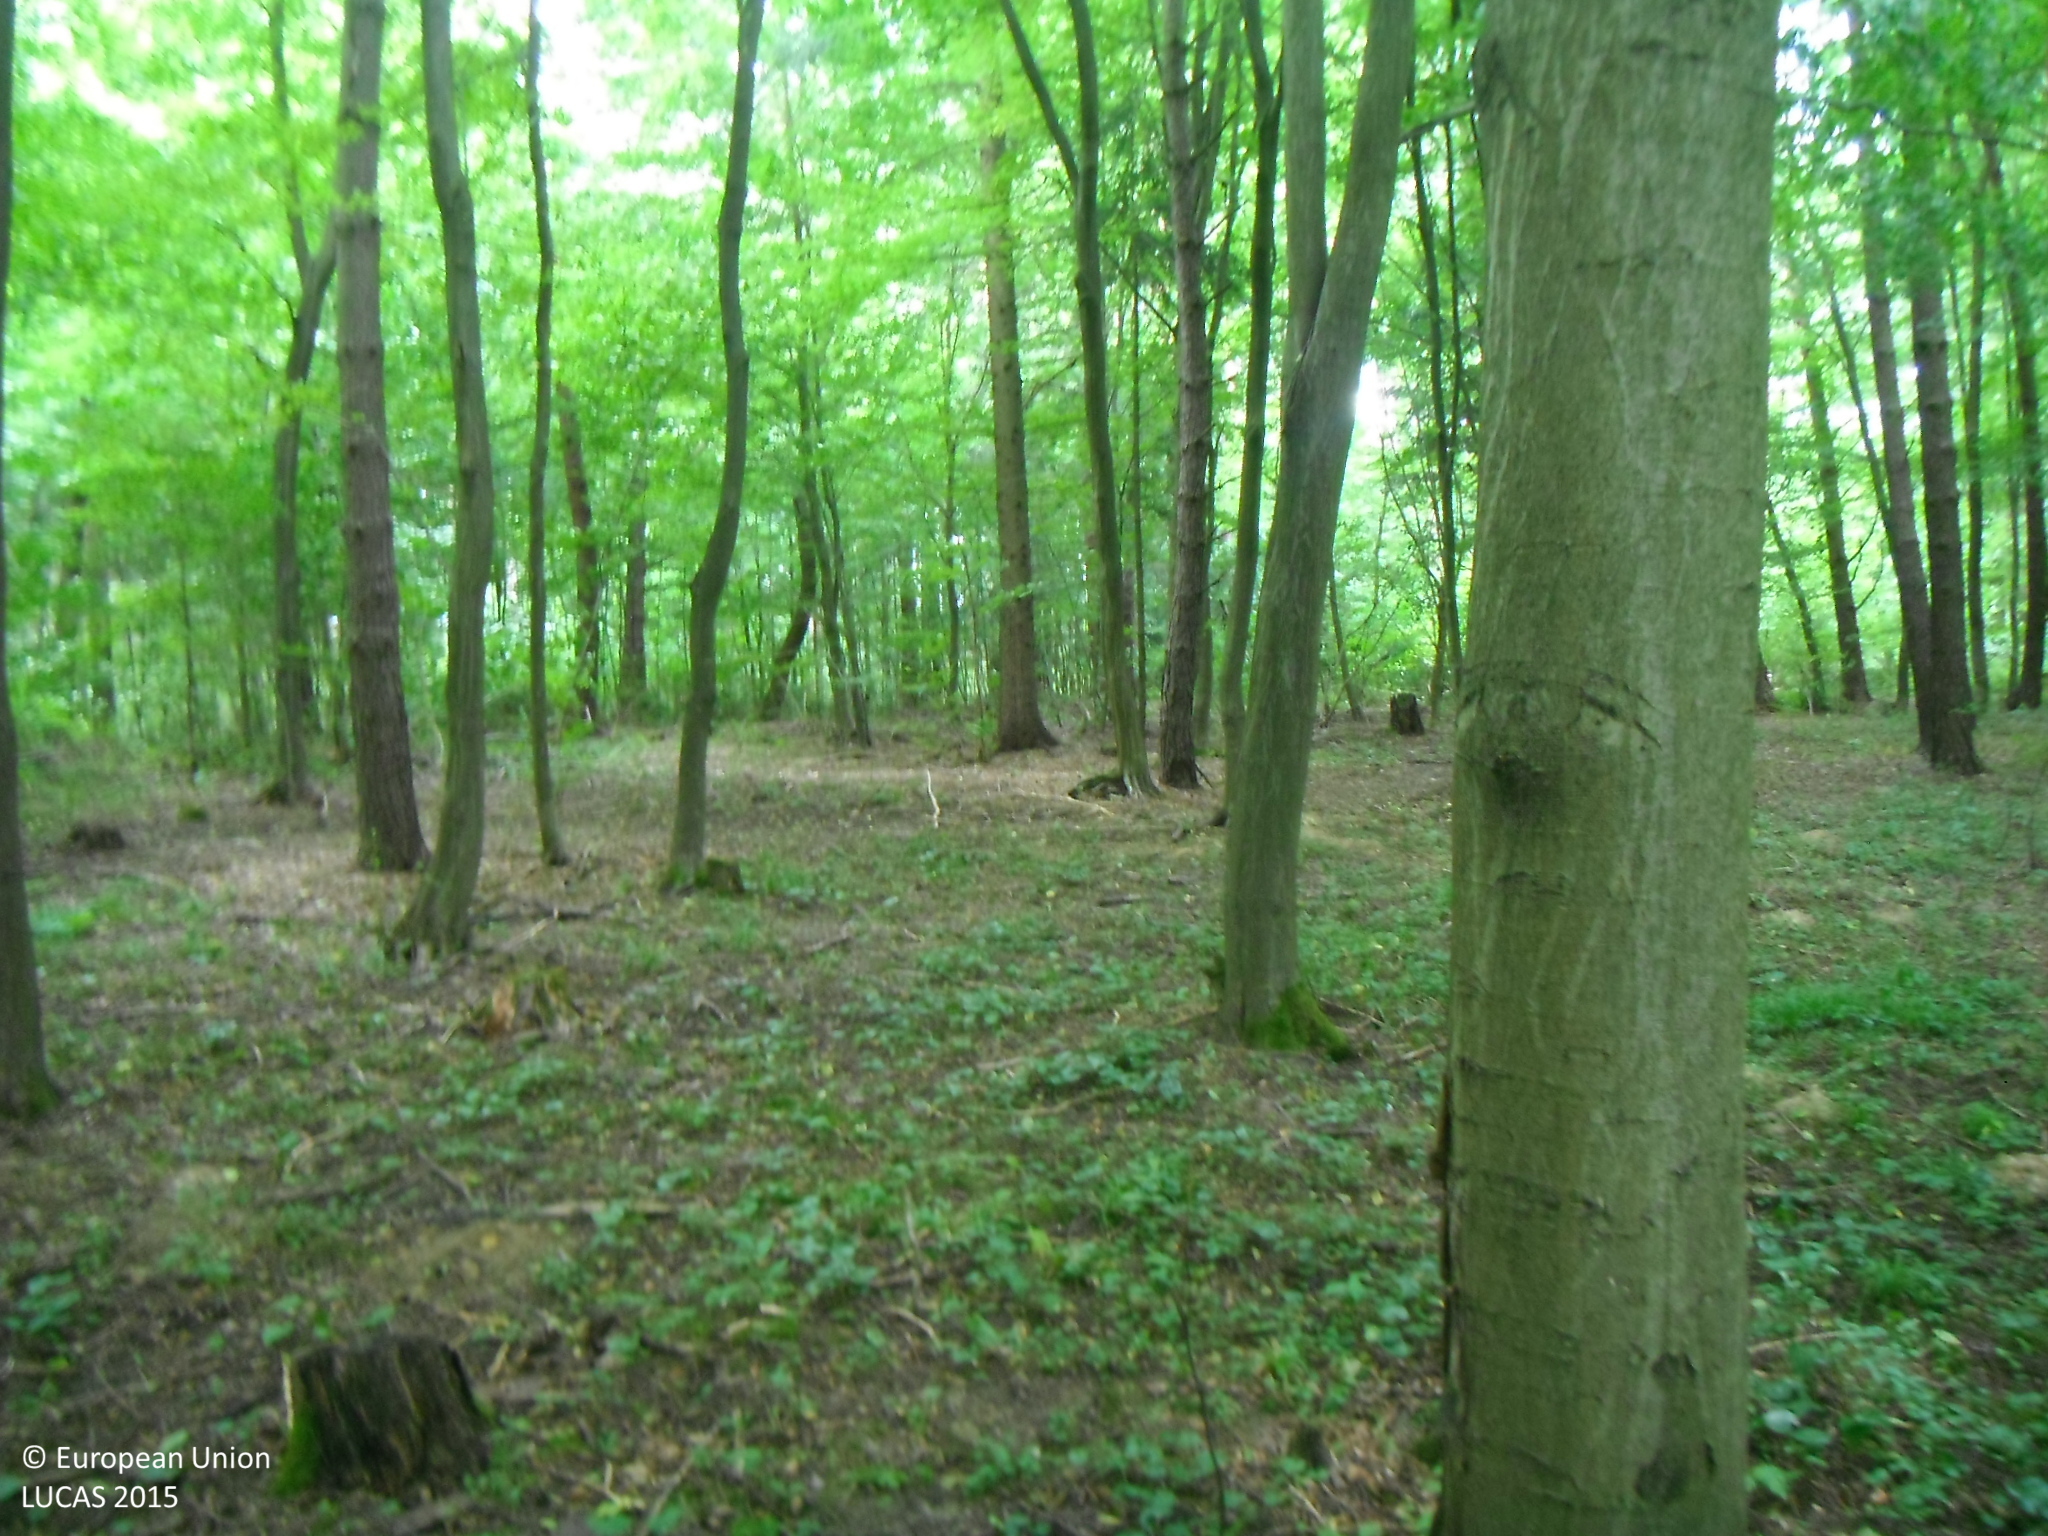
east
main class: Woodland
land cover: Pine dominated mixed woodland
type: hemiboreal forest and nemoral coniferous forest and mixed broadleaved-coniferous forest
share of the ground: > 75 %
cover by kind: coniferous forest trees 45 %, broadleaved forest trees 45 %, herbaceous plants 10 %
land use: Forestry
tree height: > 5 m
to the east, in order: Pine dominated mixed woodland; Tracks; Pine dominated mixed woodland; Spruce dominated coniferous woodland; Pine dominated mixed woodland; Grassland without tree/shrub cover; Shrubland with sparse tree cover; Pine dominated mixed woodland; Shrubland with sparse tree cover; Shrubland without tree cover; Spontaneously vegetated surfaces
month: July
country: SK
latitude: 49.0755
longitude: 18.4365
